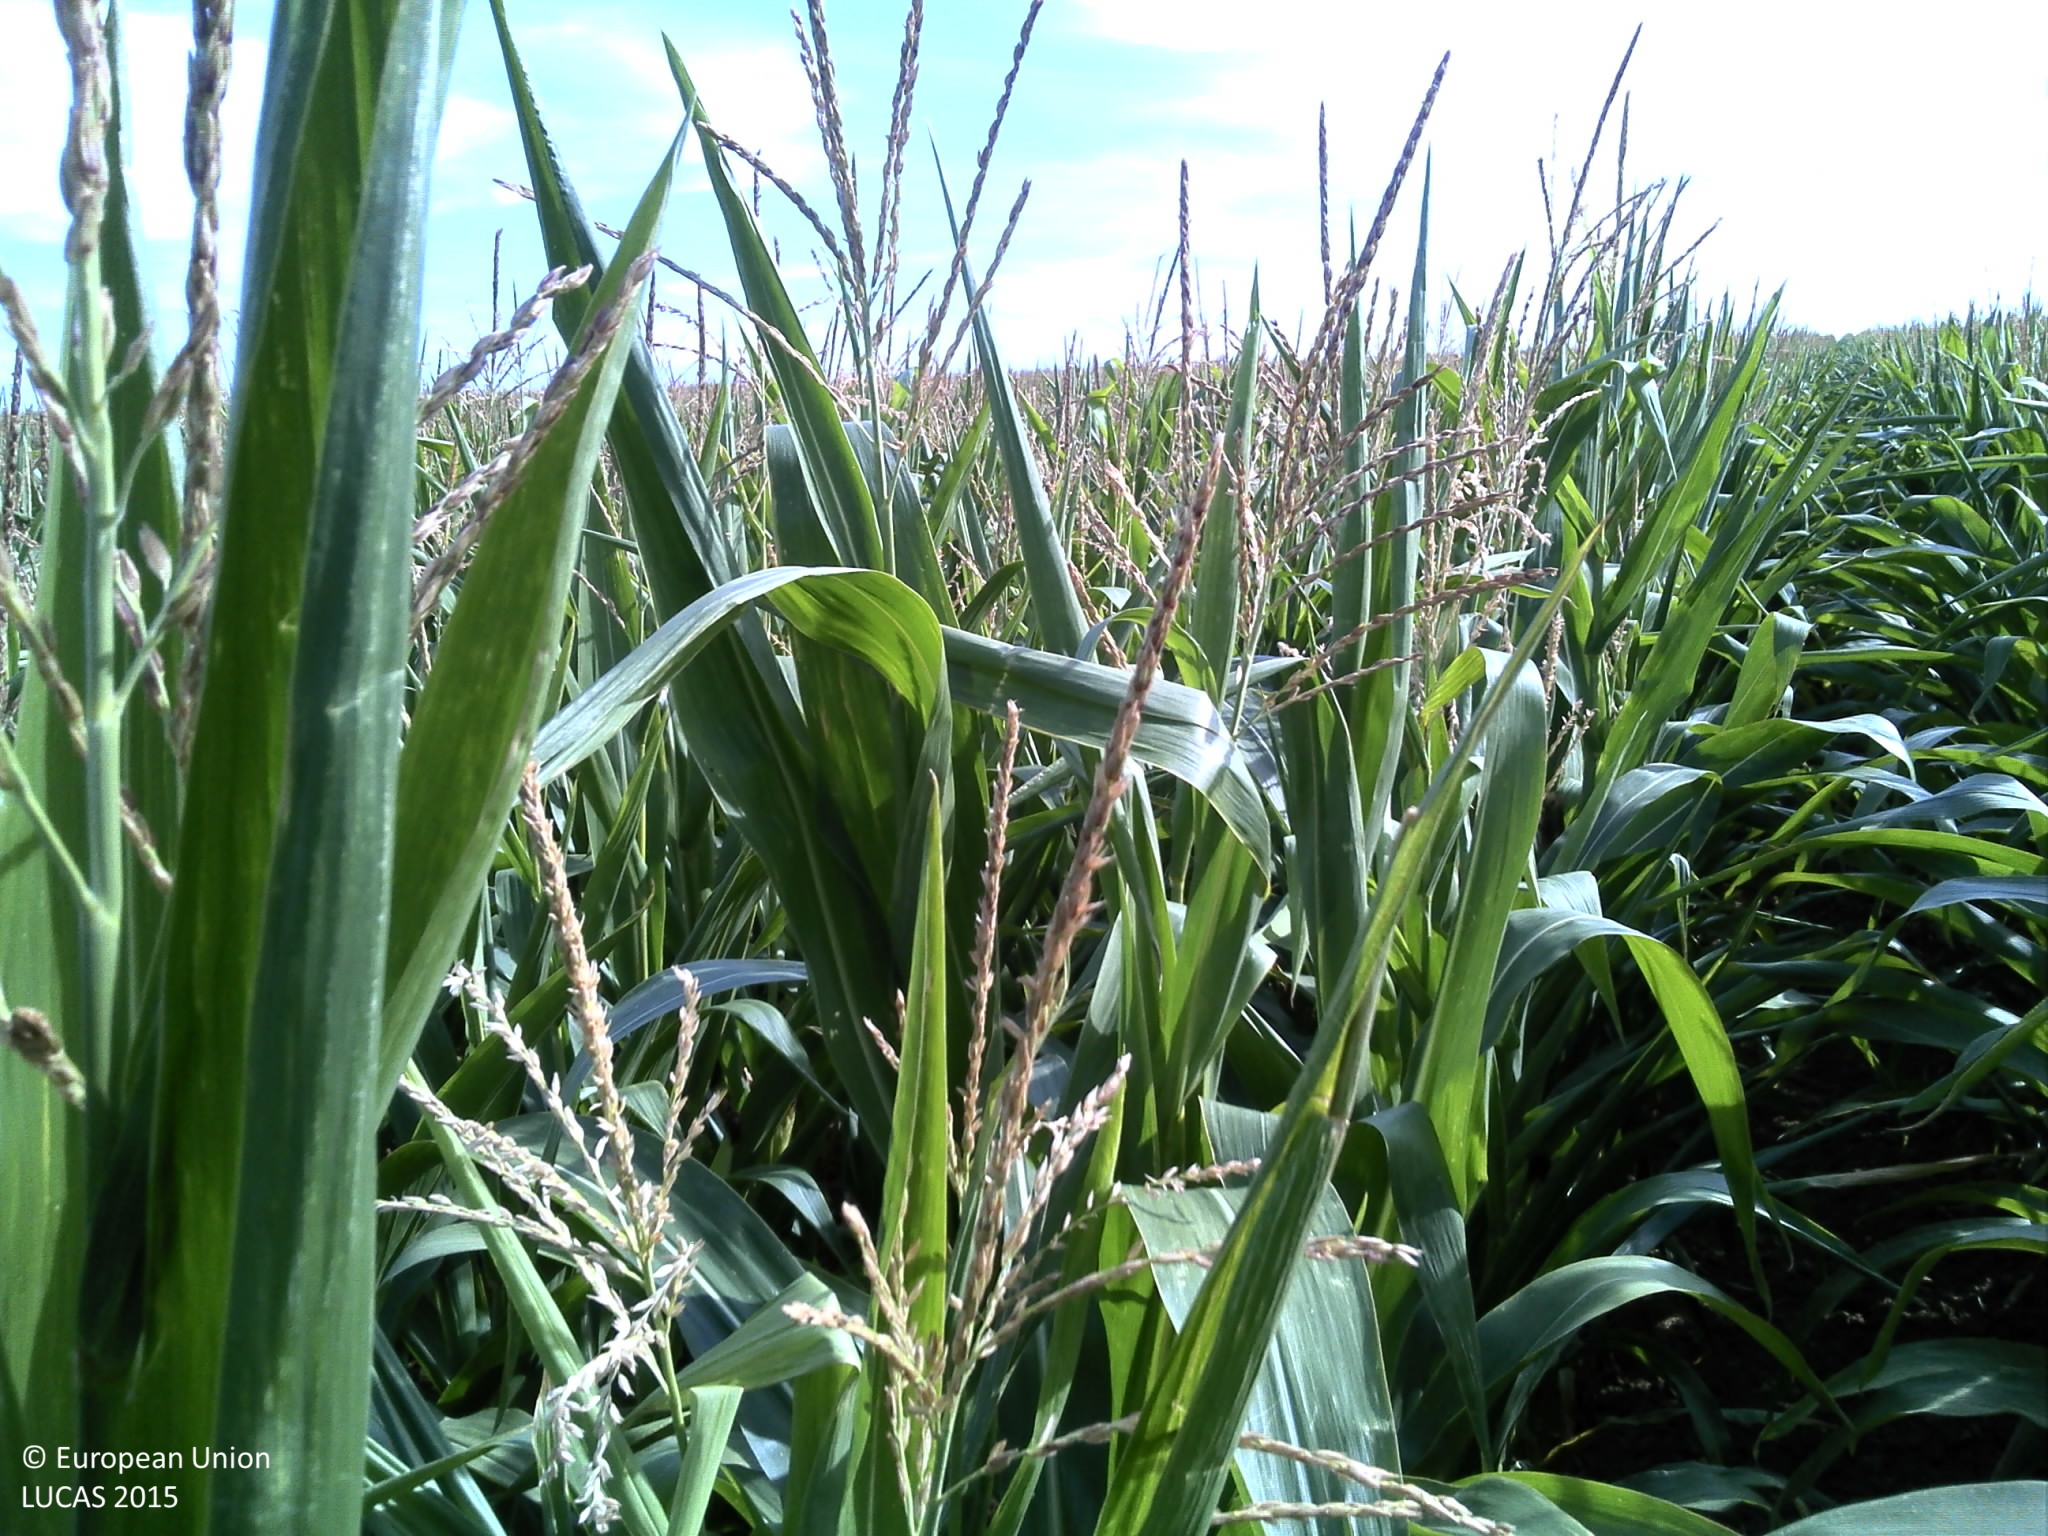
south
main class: Cropland
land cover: Maize
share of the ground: 25 - 50 %
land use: Agriculture (excluding fallow land and kitchen gardens)
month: August
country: FR
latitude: 48.9864
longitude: 4.8458
